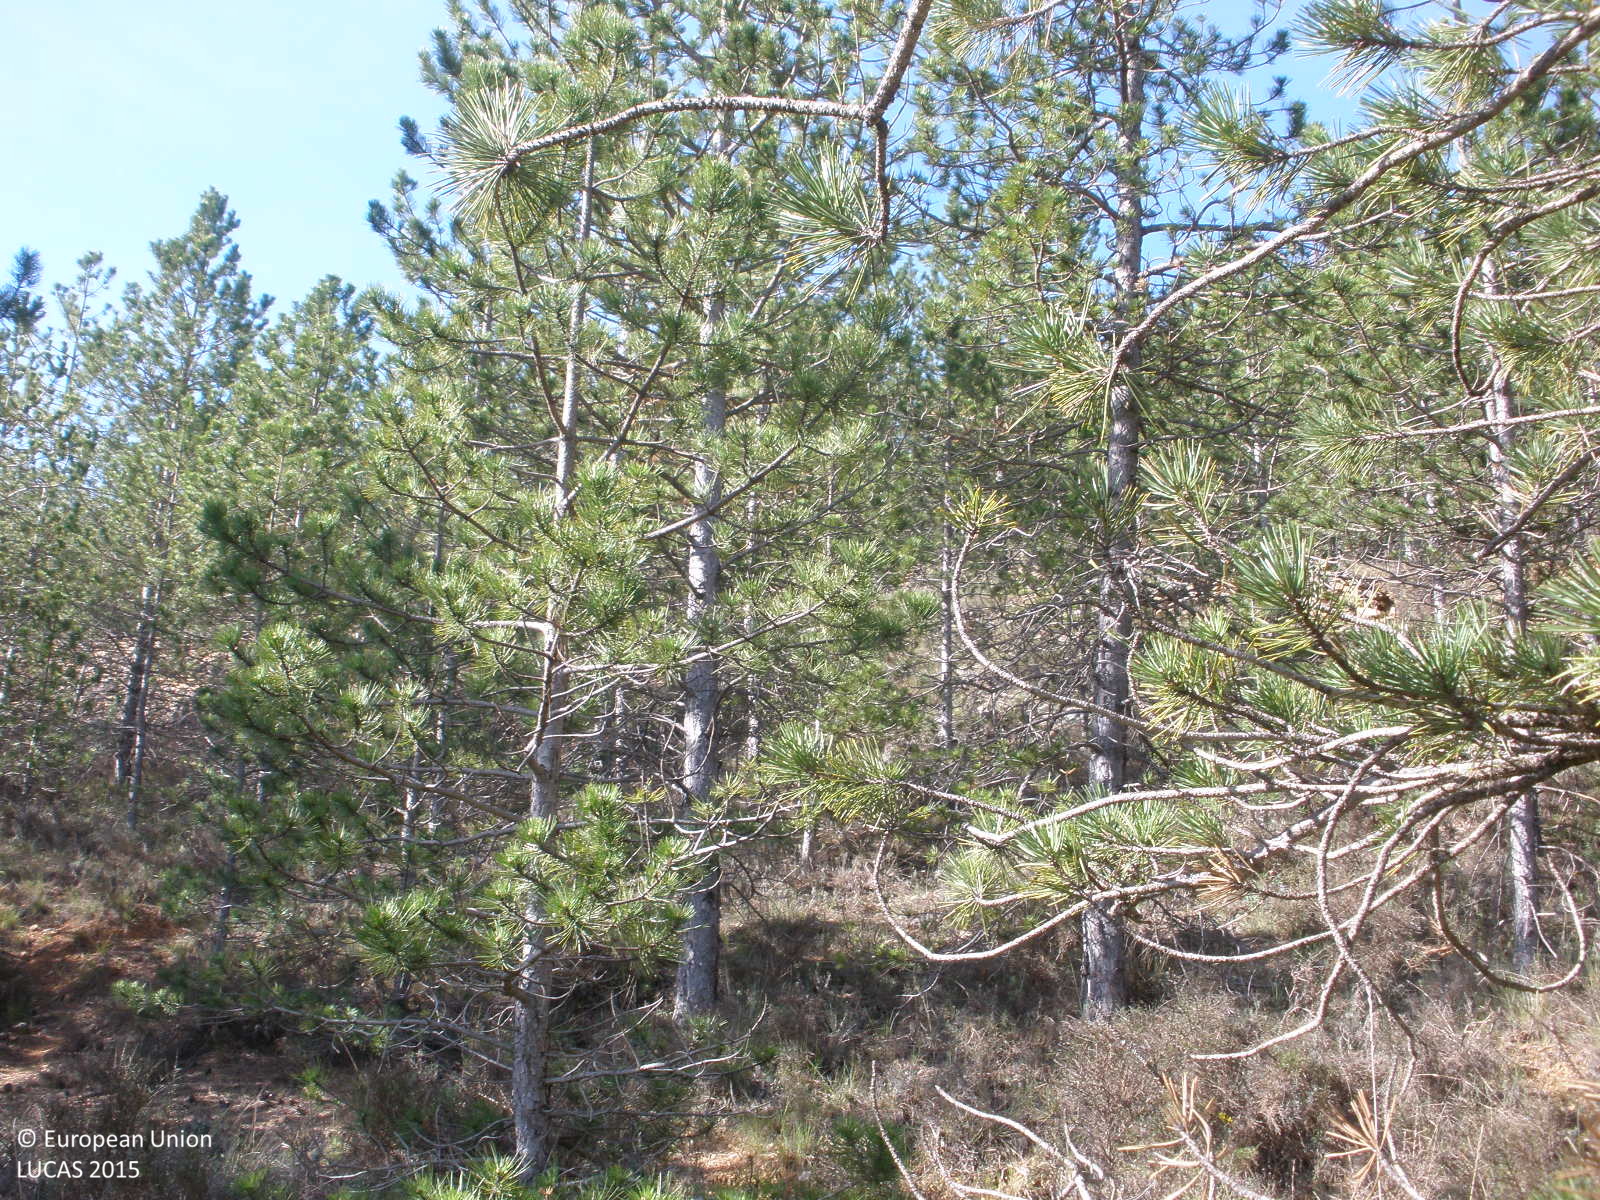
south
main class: Woodland
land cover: Pine dominated coniferous woodland
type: coniferous forest of the mediterranean region
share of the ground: 25 - 50 %
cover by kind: coniferous forest trees 40 %, shrubs 40 %, herbaceous plants 20 %
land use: Semi-natural and natural areas not in use
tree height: > 5 m
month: April
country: ES
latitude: 40.0819
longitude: -1.1845
